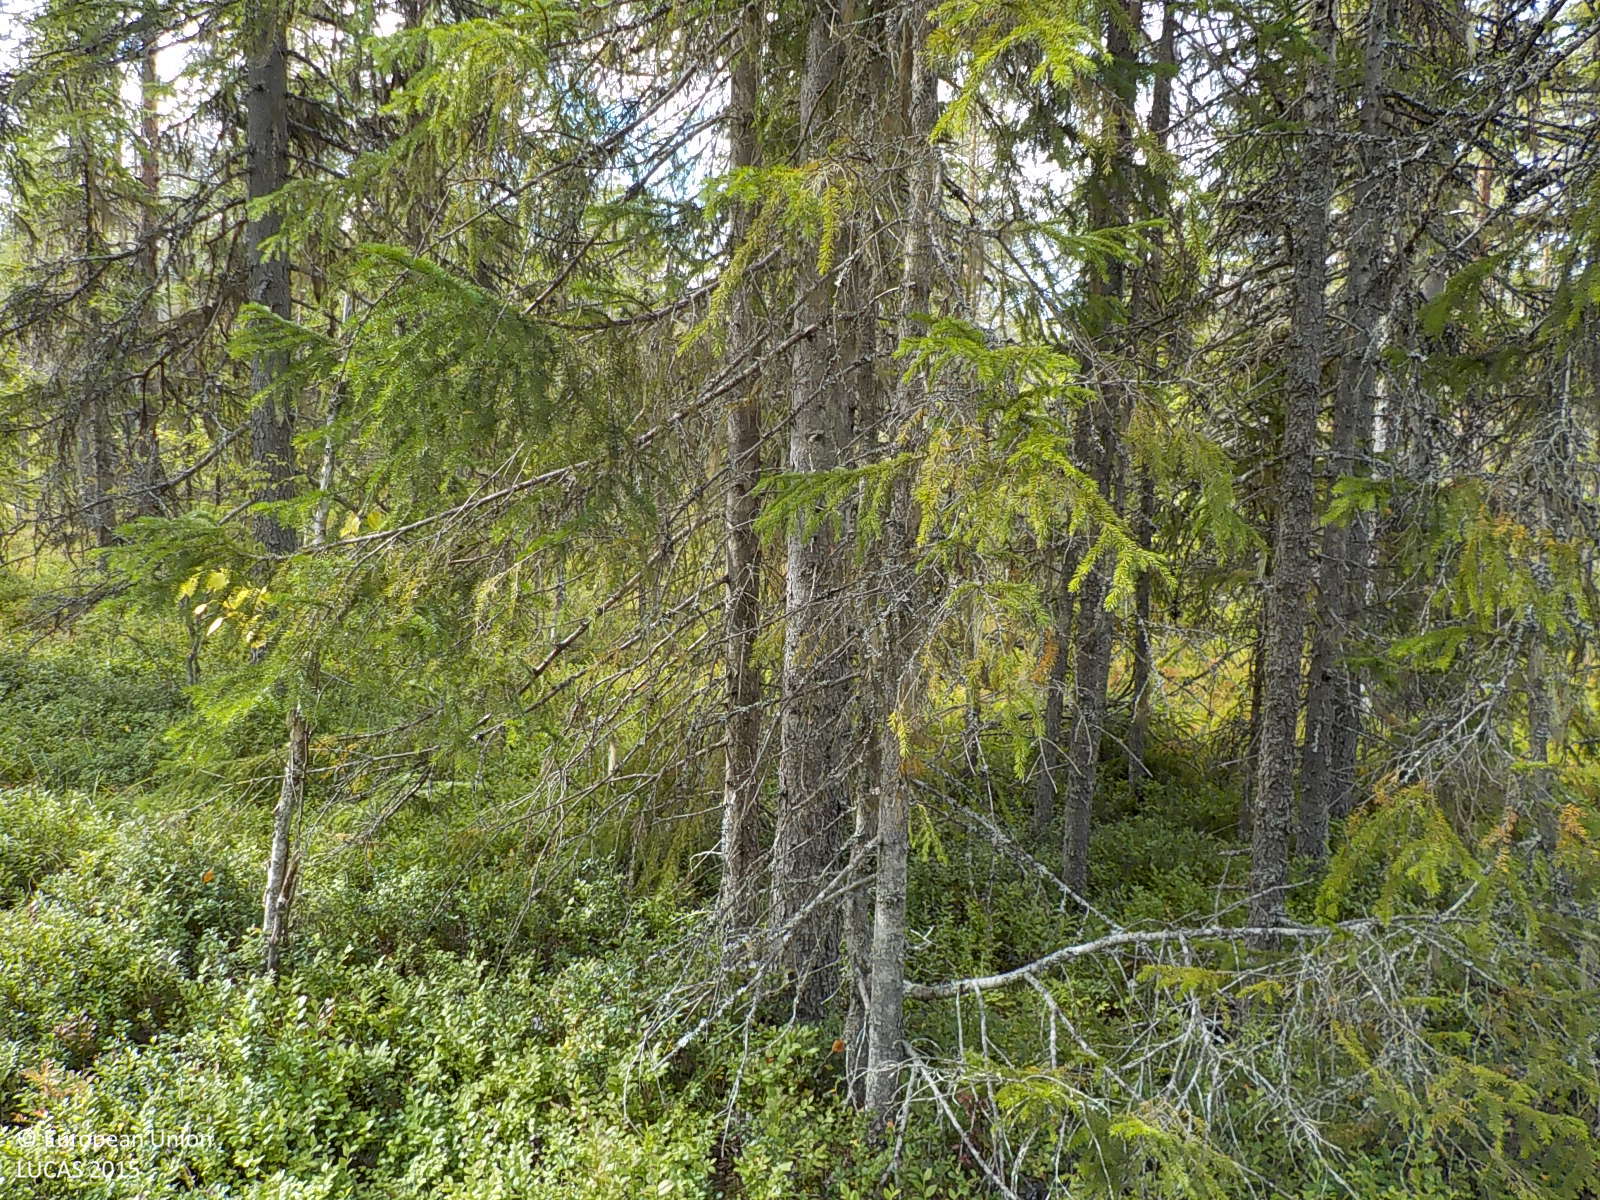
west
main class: Woodland
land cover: Pine dominated coniferous woodland
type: boreal forest
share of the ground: 50 - 75 %
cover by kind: coniferous forest trees 65 %, shrubs 35 %
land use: Forestry
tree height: > 5 m
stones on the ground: 25 - 50 %
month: September
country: SE
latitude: 63.3788
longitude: 17.2757
